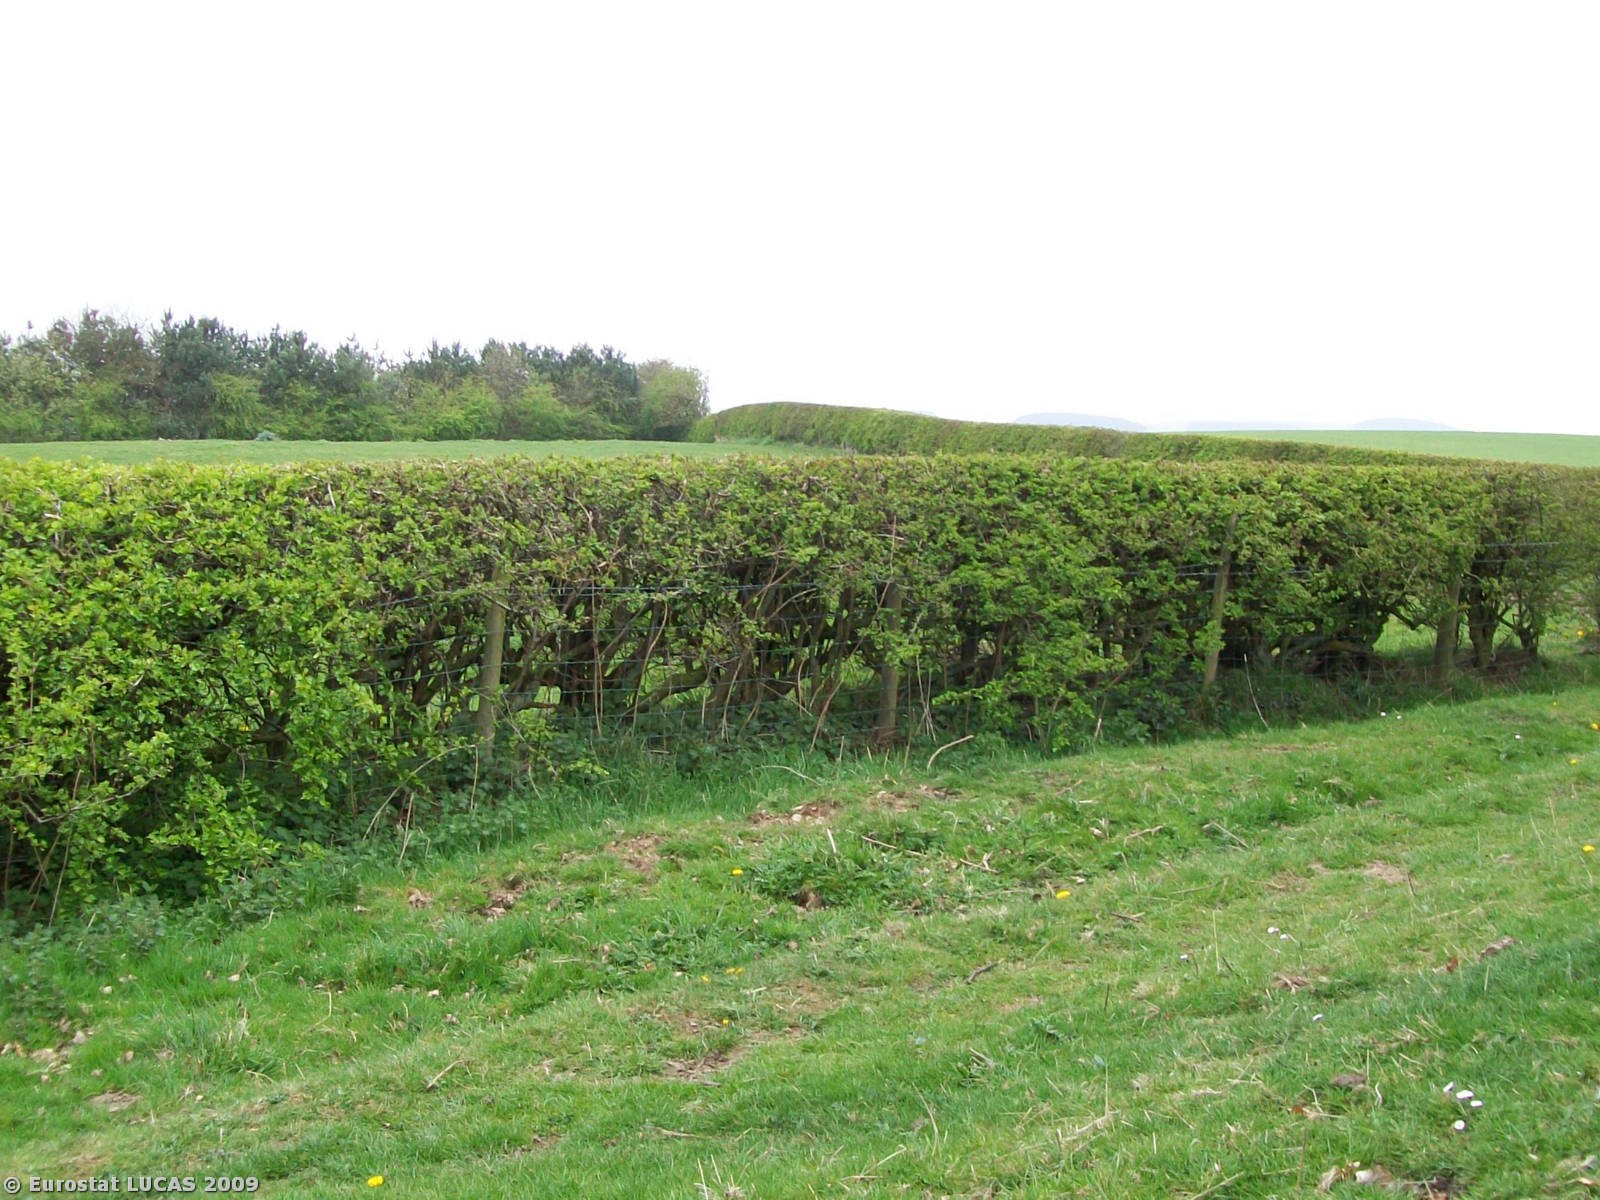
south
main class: Grassland
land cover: Grassland with sparse tree/shrub cover
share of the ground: 10 - 25 %
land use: Agriculture (excluding fallow land and kitchen gardens)
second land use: Community services
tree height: > 5 m
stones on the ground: < 10 %
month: April
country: GB
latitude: 54.8015
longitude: -1.6391
